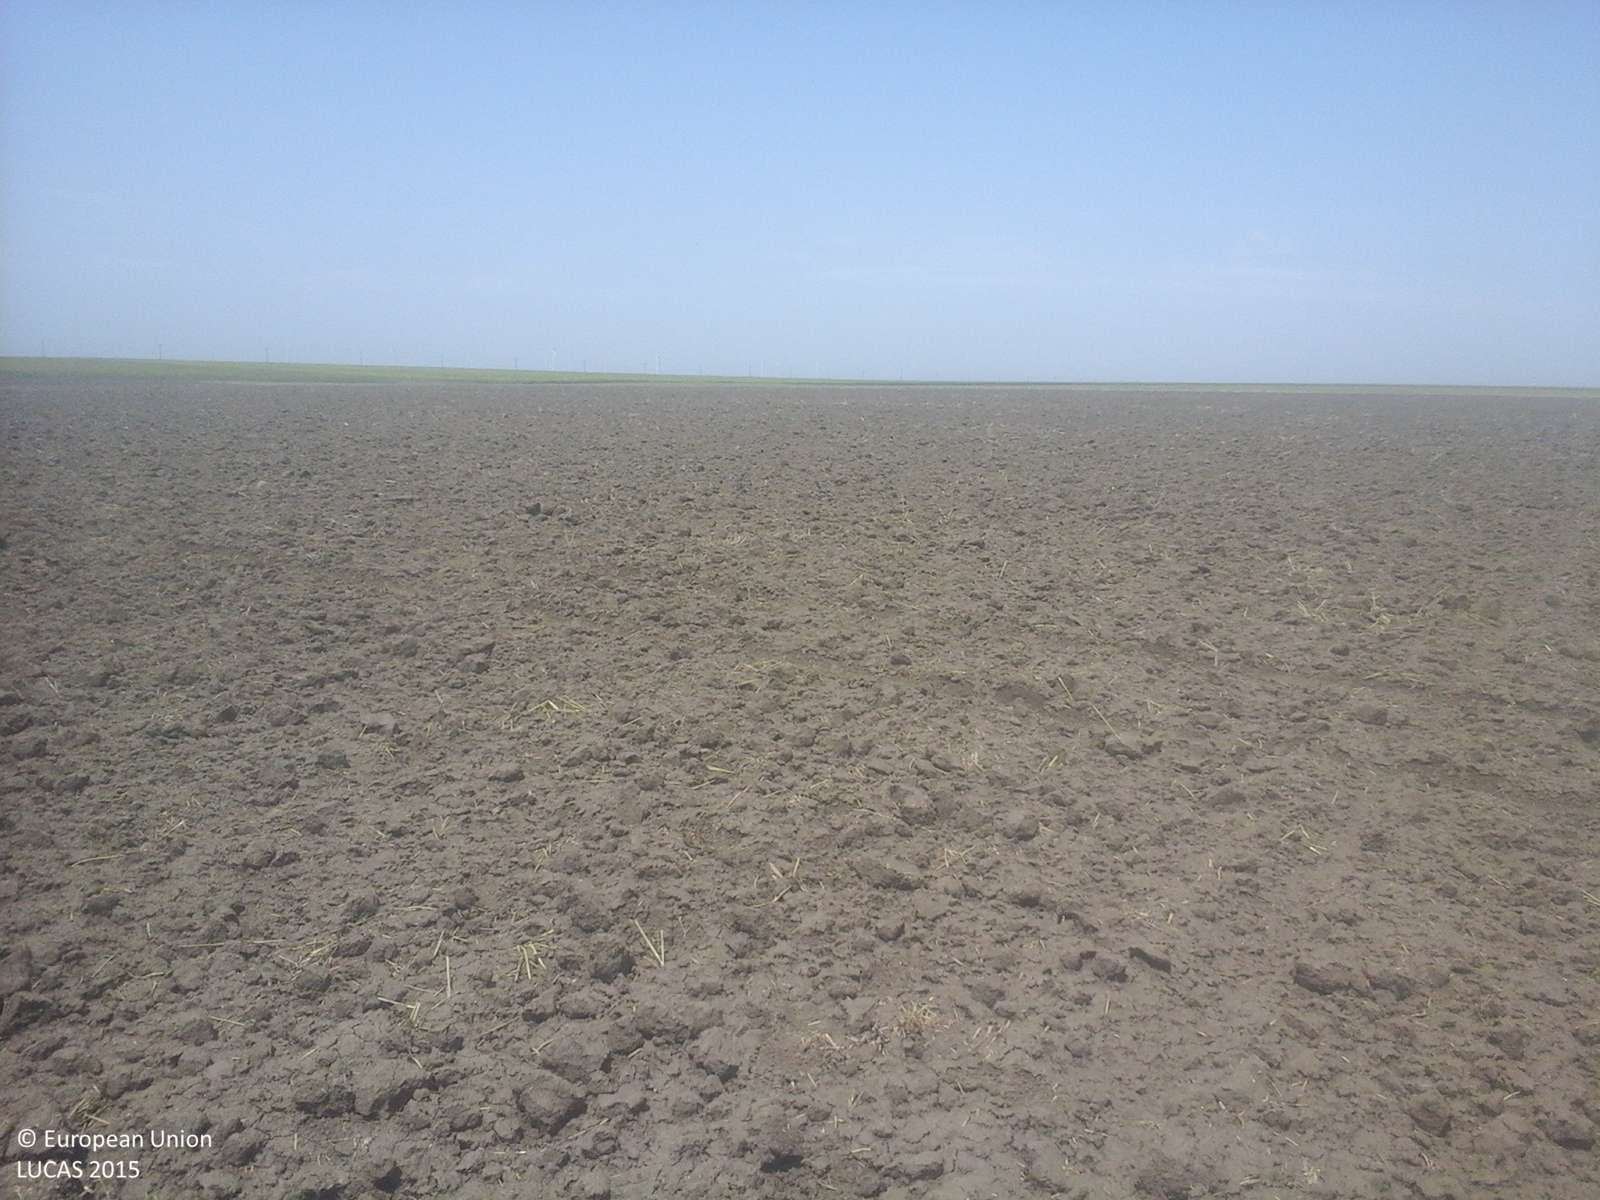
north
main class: Cropland
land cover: Common wheat
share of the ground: < 10 %
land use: Agriculture (excluding fallow land and kitchen gardens)
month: August
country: RO
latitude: 43.8446
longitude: 28.2301
